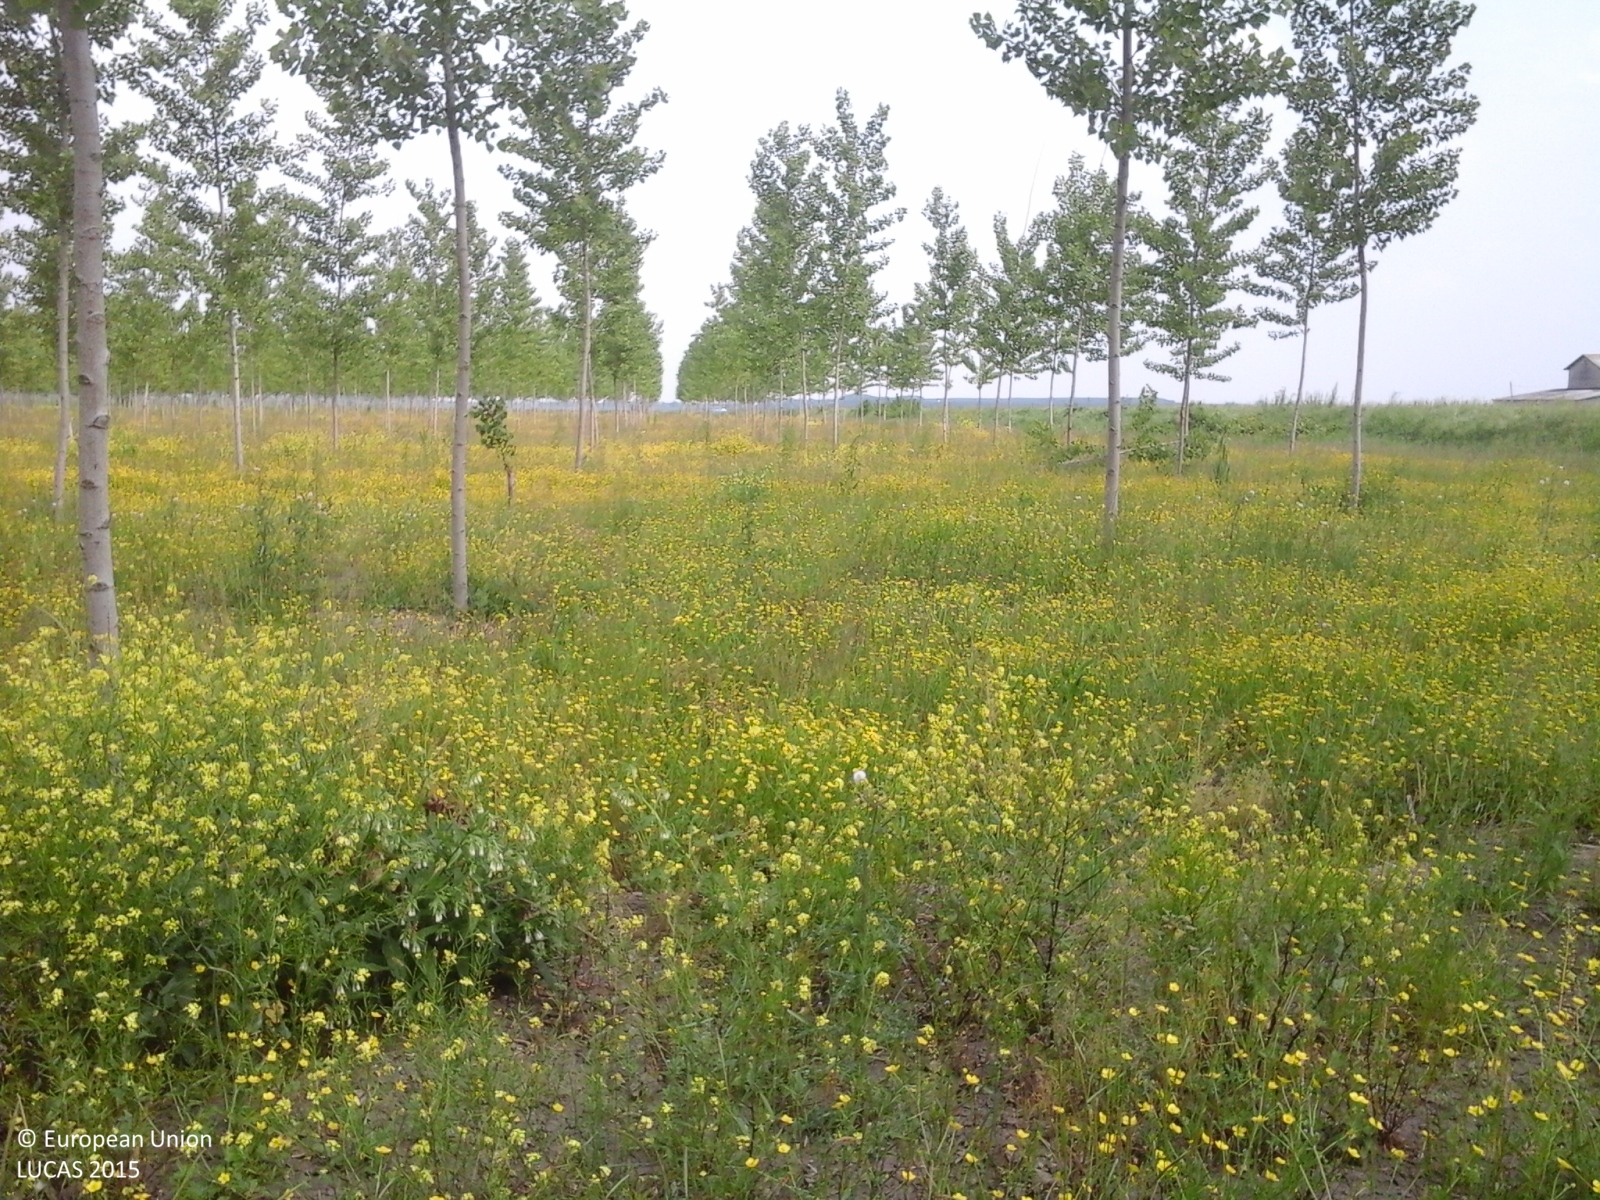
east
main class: Woodland
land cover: Broadleaved woodland
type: non-riverine alder, birch or aspen forest
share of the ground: 10 - 25 %
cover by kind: herbaceous plants 80 %, broadleaved forest trees 20 %
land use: Forestry
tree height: > 5 m
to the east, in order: Broadleaved woodland; Inland fresh running water; Grassland without tree/shrub cover; Tracks; Ditches and canals; Grass margins; Tracks; Grass margins; Spontaneously vegetated surfaces
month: May
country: IT
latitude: 44.8892
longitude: 10.6950
